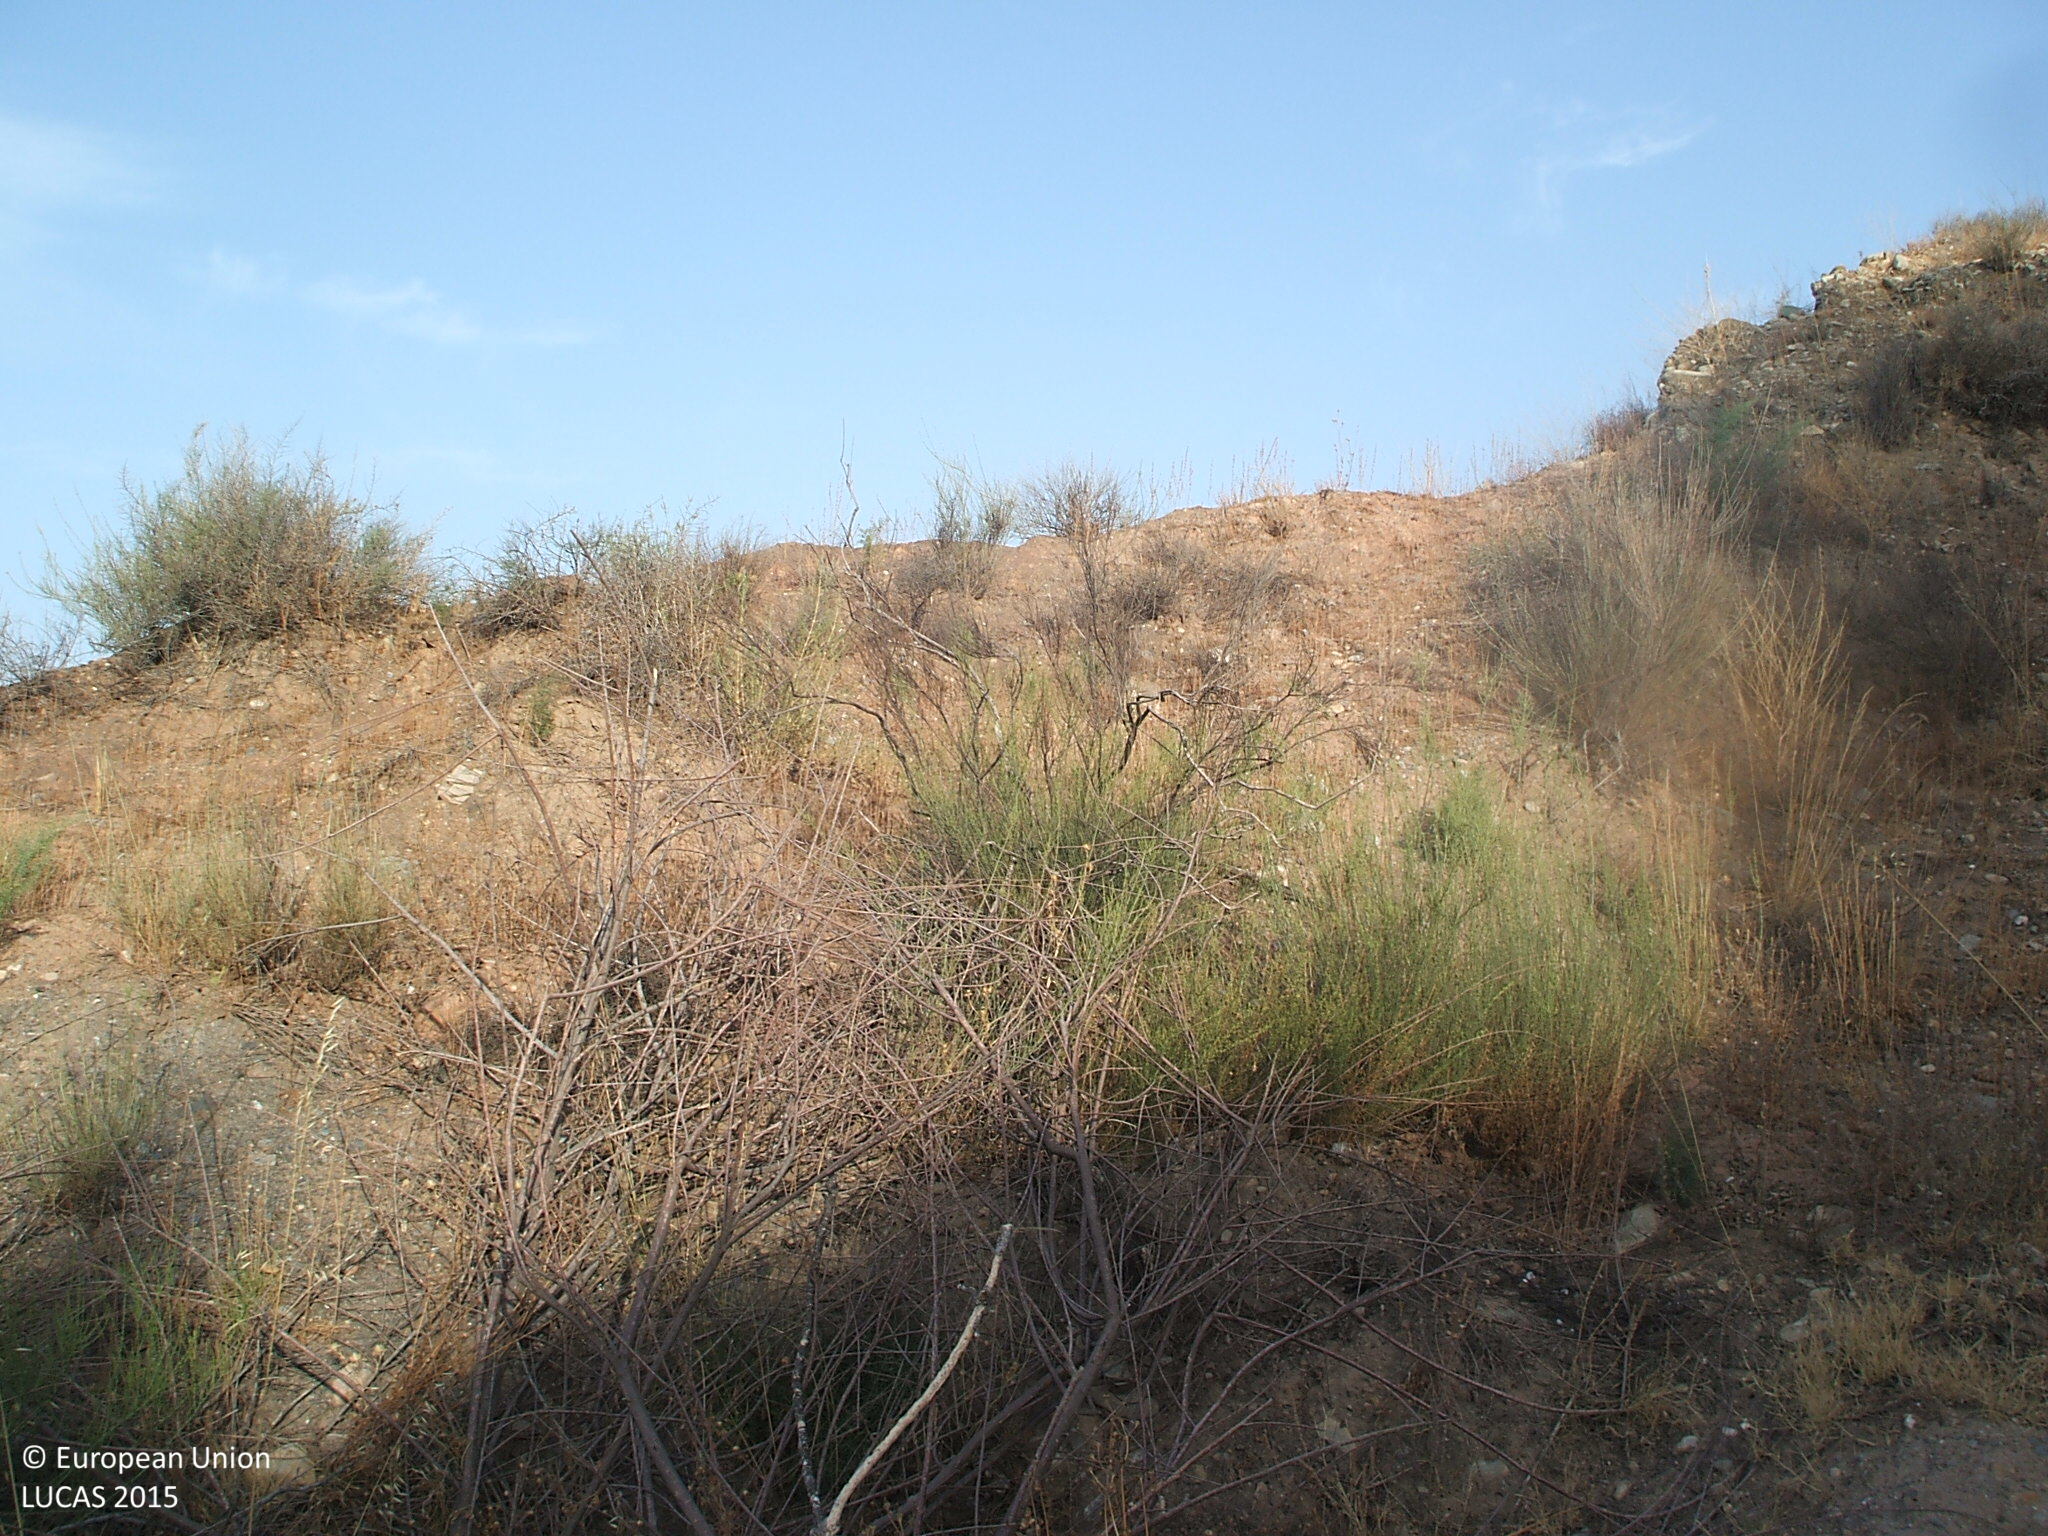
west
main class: Grassland
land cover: Grassland without tree/shrub cover
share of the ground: > 75 %
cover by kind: herbaceous plants 95 %, unconsolidated bare surface 5 %
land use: Semi-natural and natural areas not in use
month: July
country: ES
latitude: 37.3579
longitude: -2.2312
